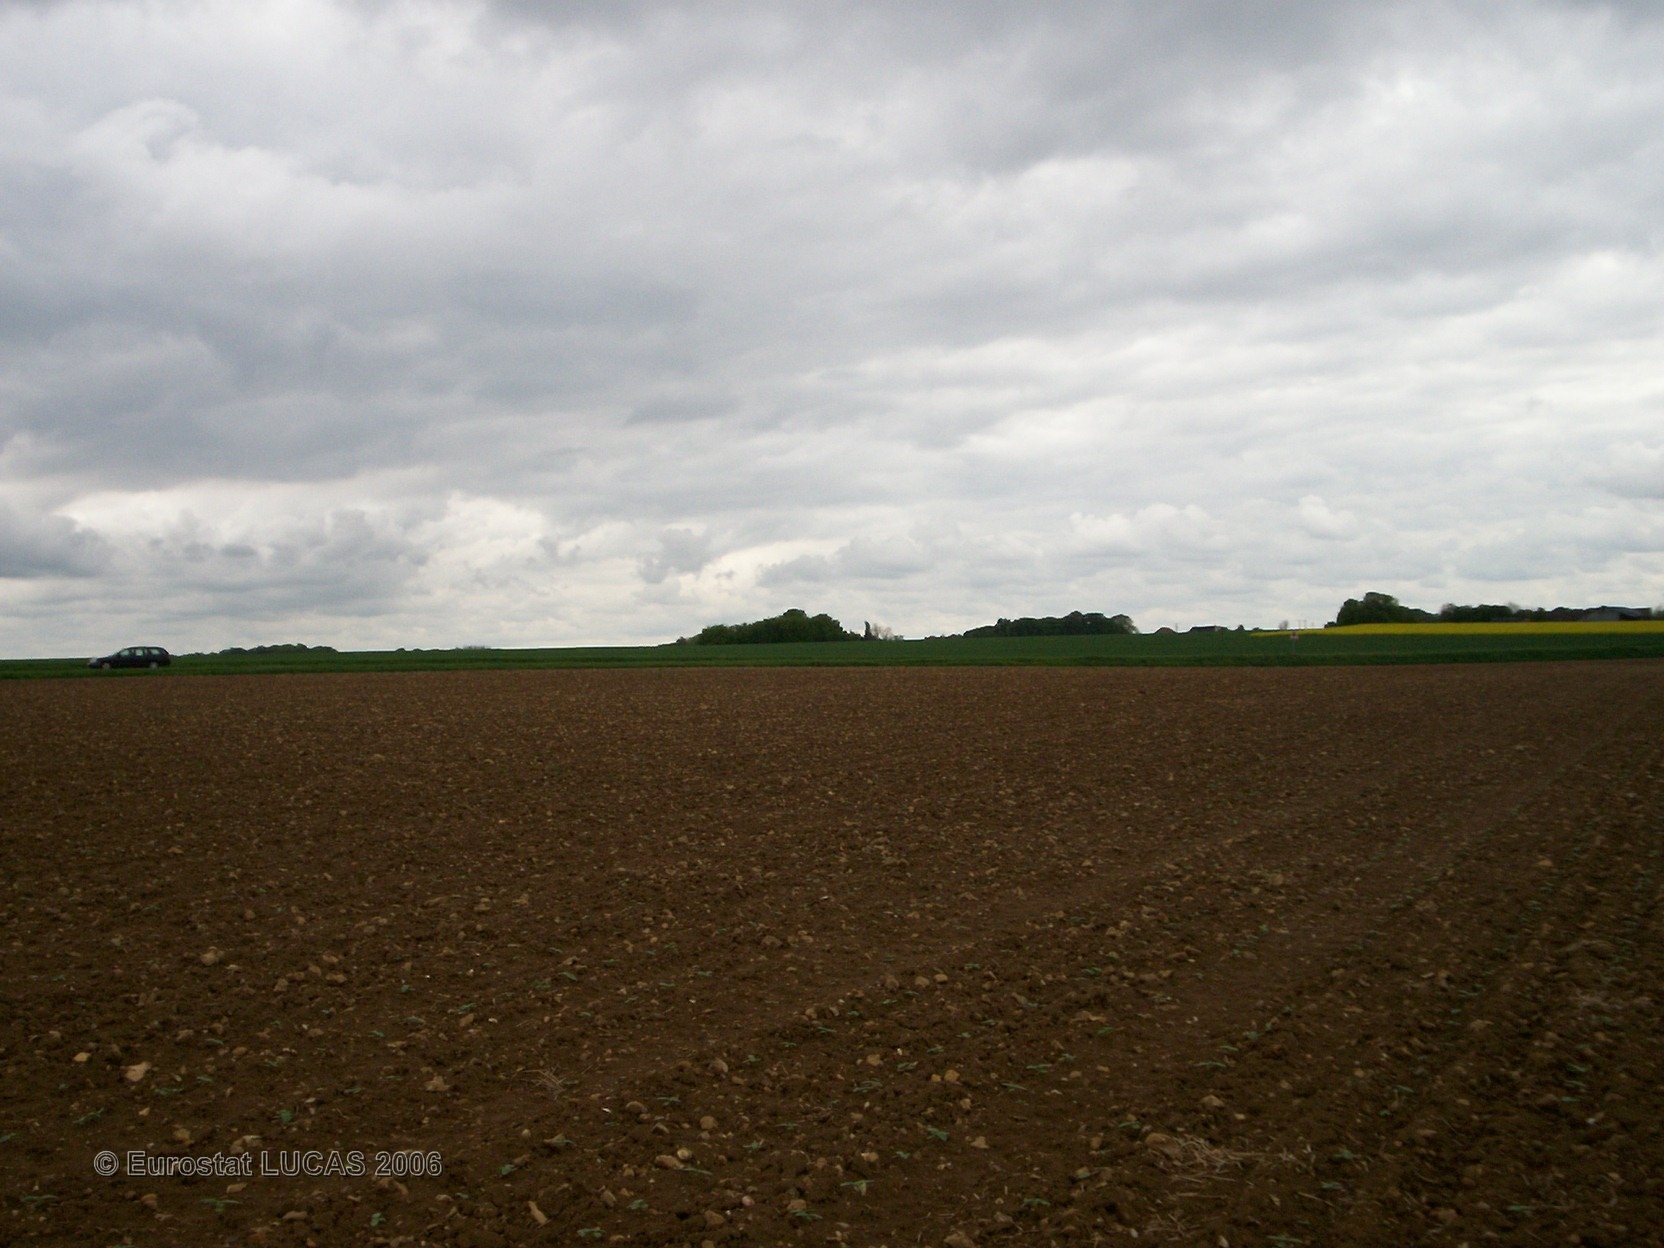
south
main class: Cropland
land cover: Sunflower
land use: Agriculture (excluding fallow land and kitchen gardens)
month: May
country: FR
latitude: 48.0178
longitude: 2.9809
